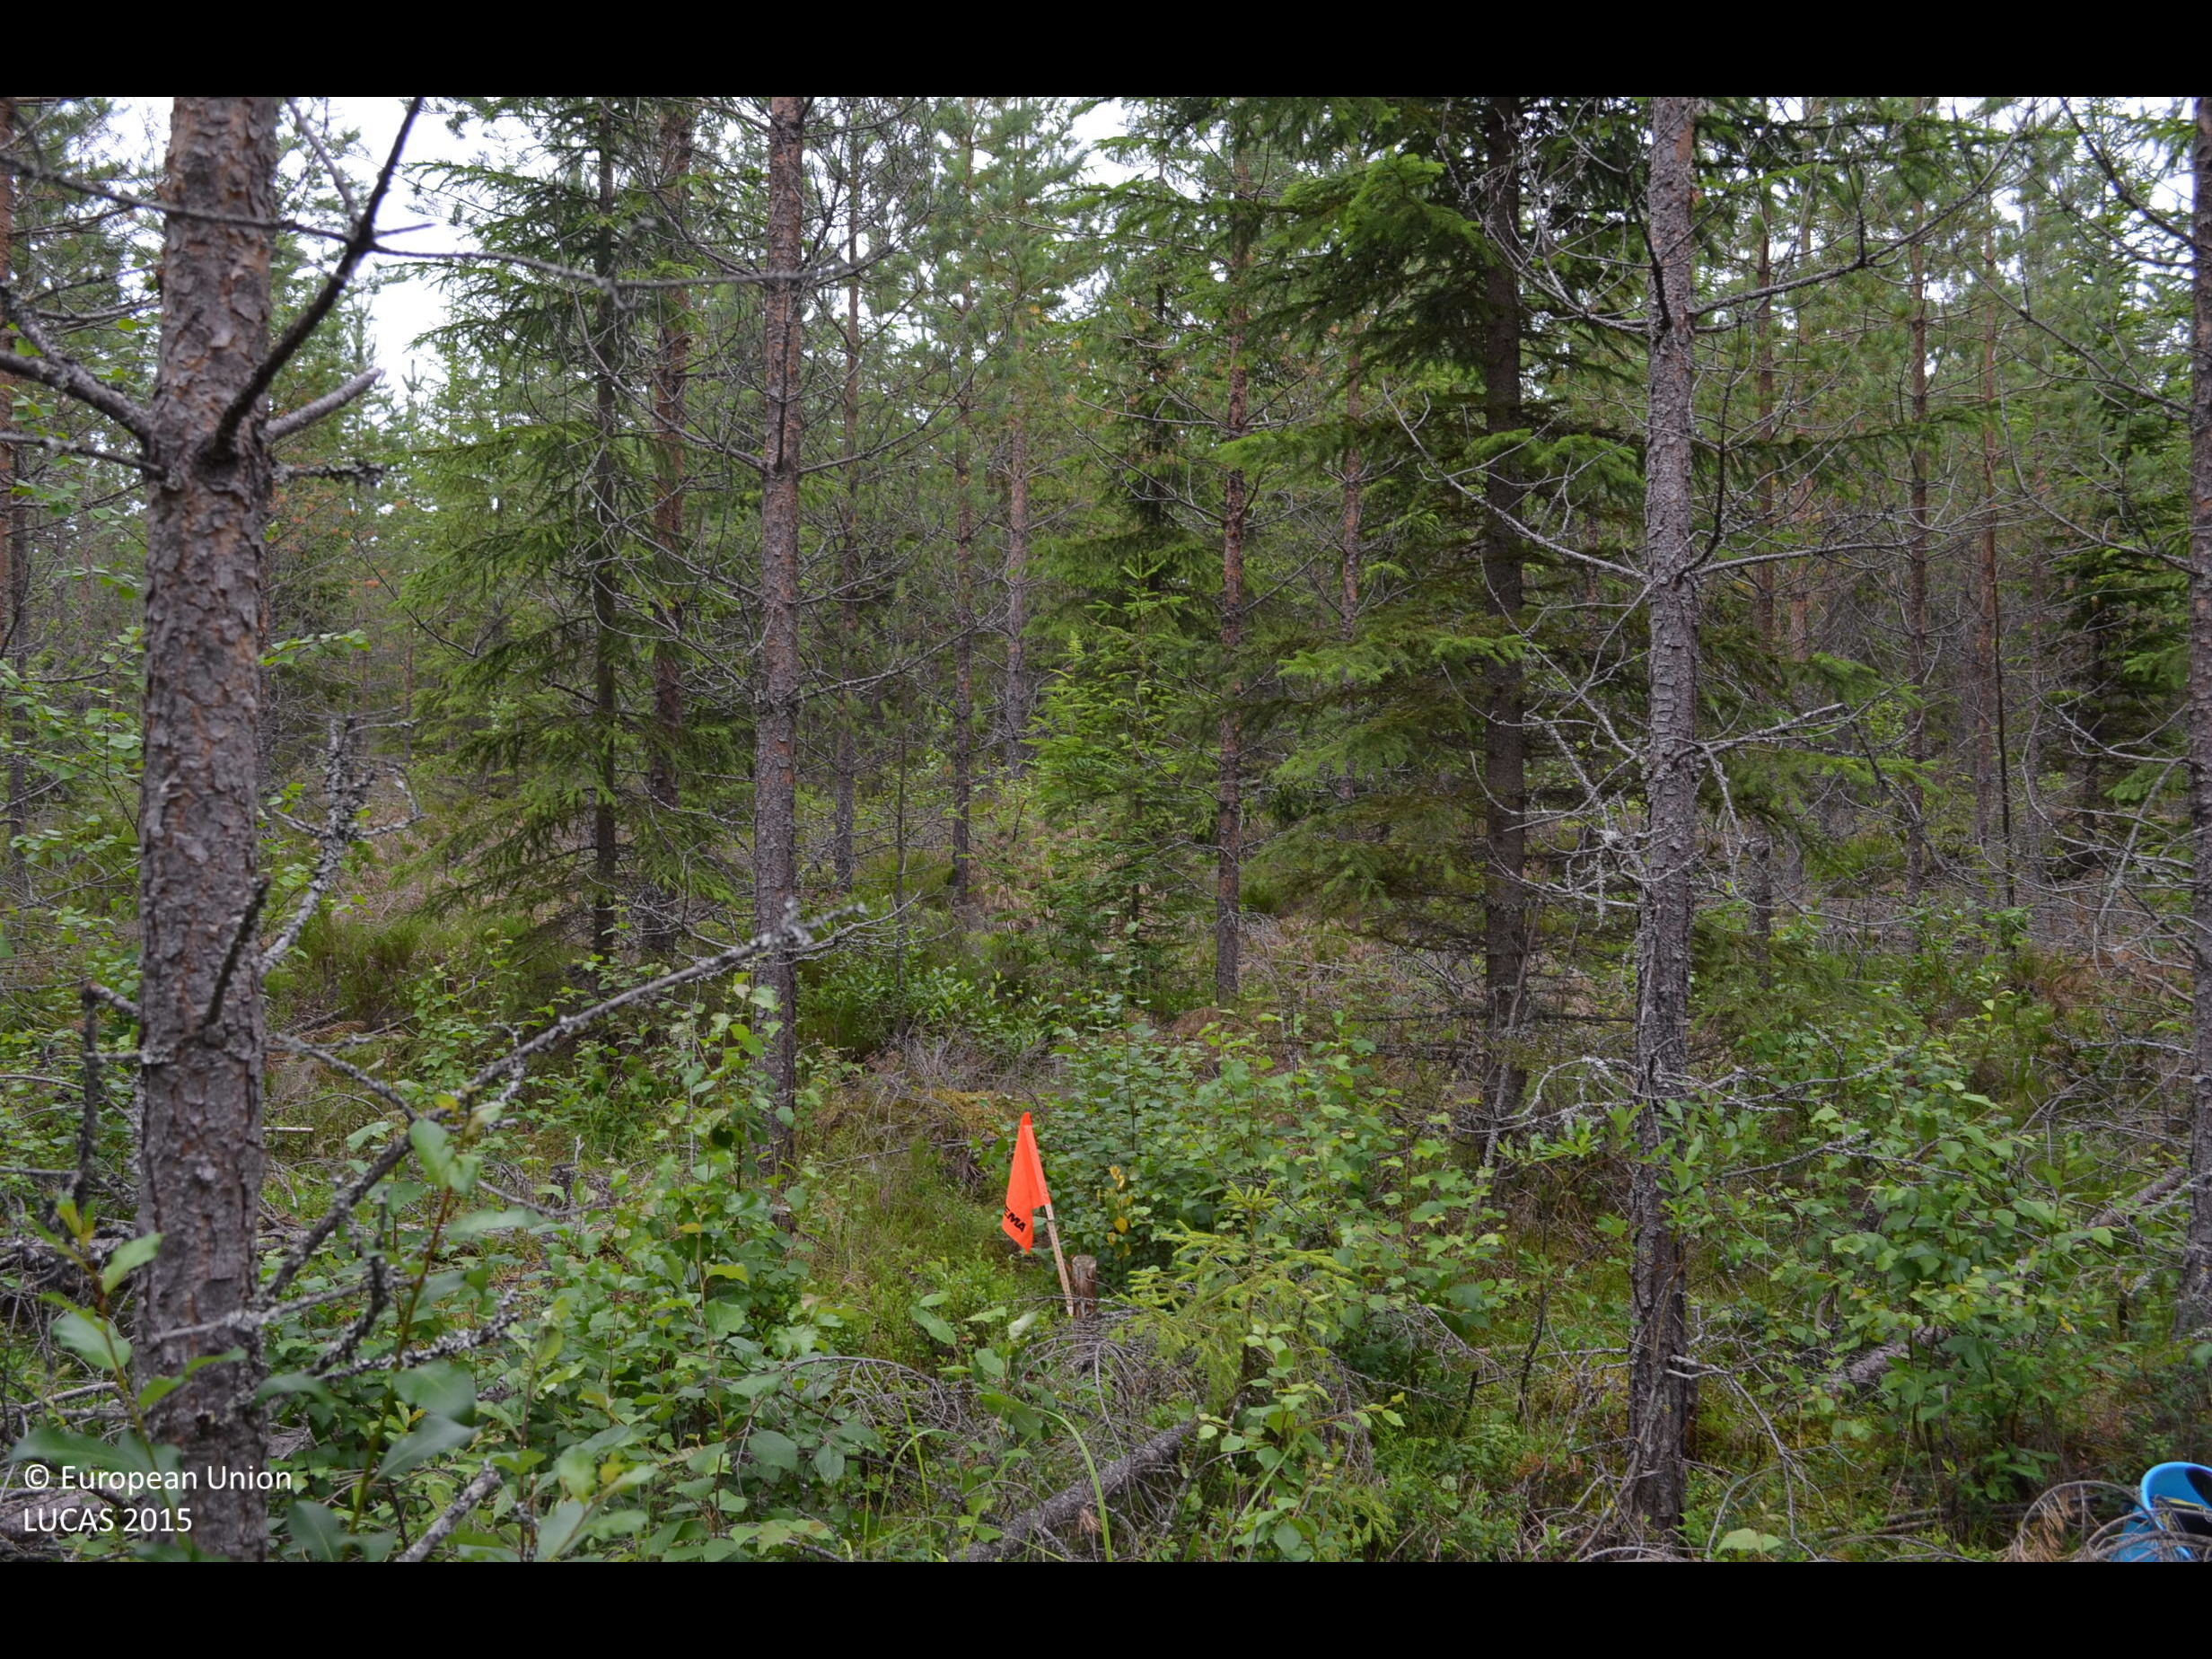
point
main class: Woodland
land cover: Other coniferous woodland
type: boreal forest
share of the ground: > 75 %
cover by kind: coniferous forest trees 80 %, shrubs 15 %
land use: Forestry
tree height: > 5 m
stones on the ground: < 10 %
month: July
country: FI
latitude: 62.2580
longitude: 23.4950
